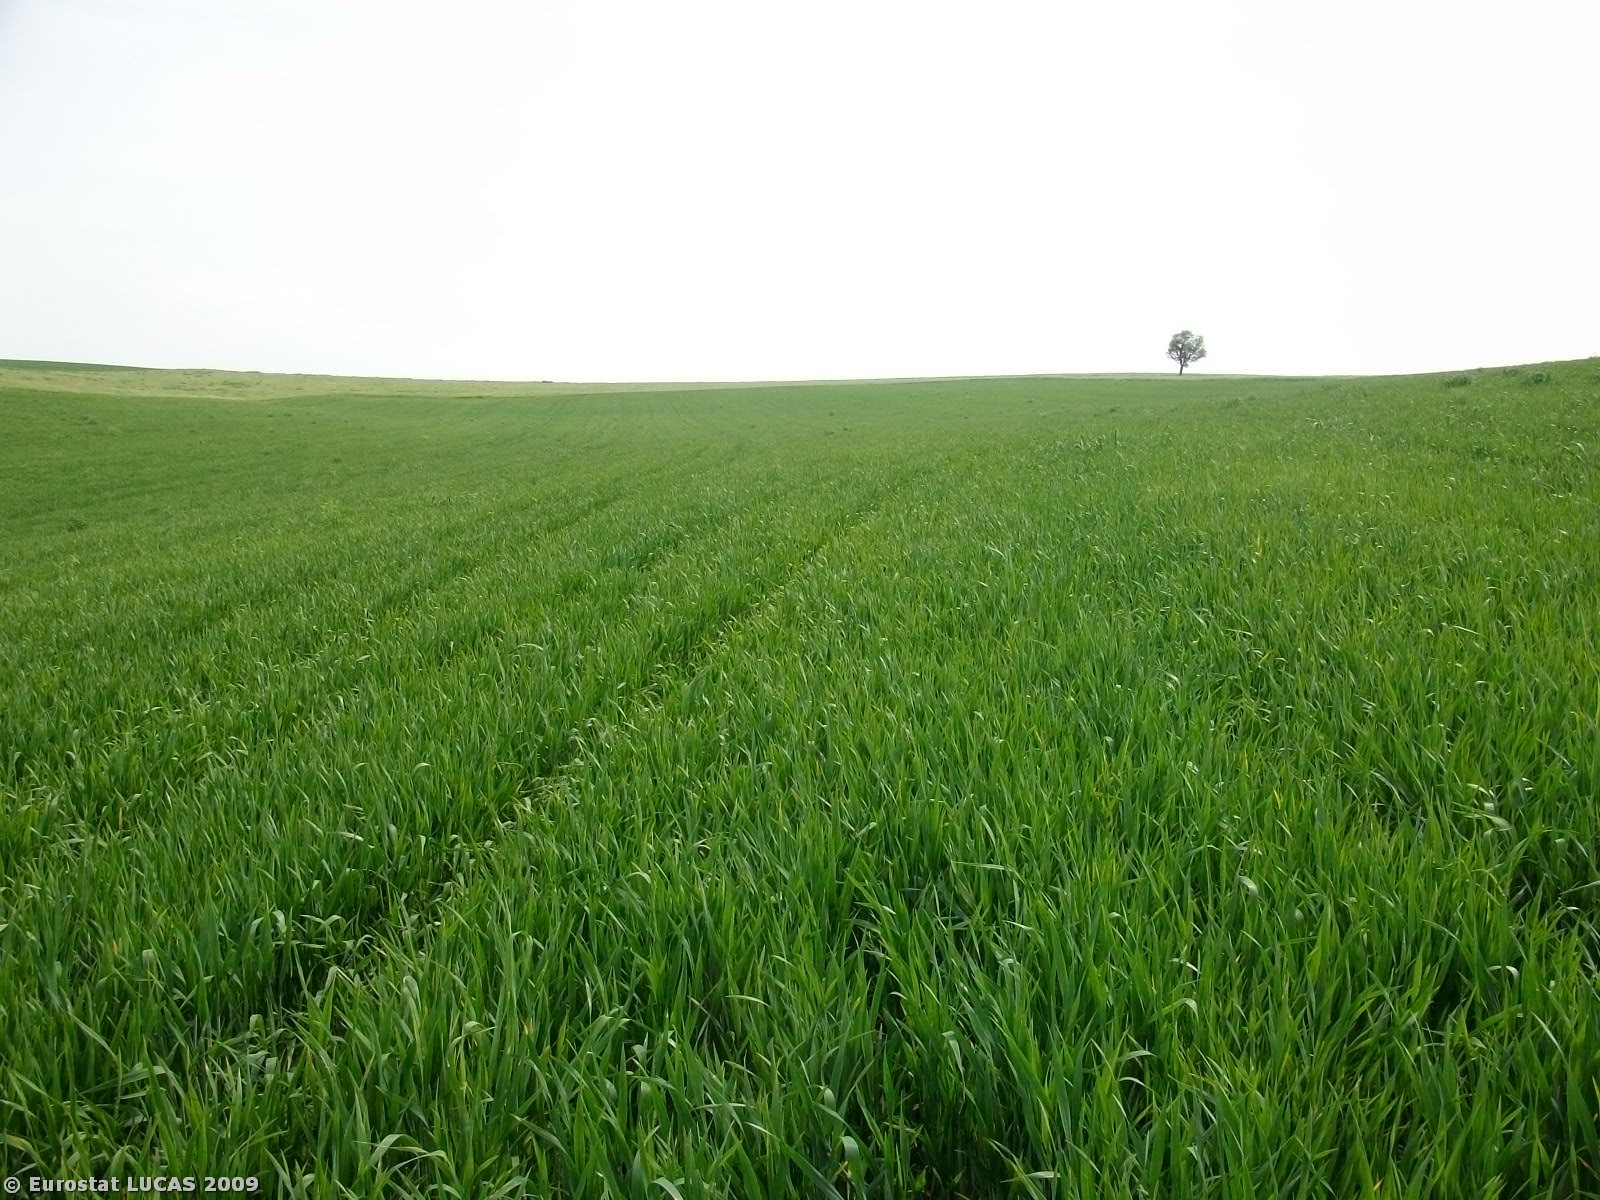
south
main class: Cropland
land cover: Durum wheat
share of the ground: > 75 %
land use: Agriculture (excluding fallow land and kitchen gardens)
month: April
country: GR
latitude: 39.4845
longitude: 22.4869
